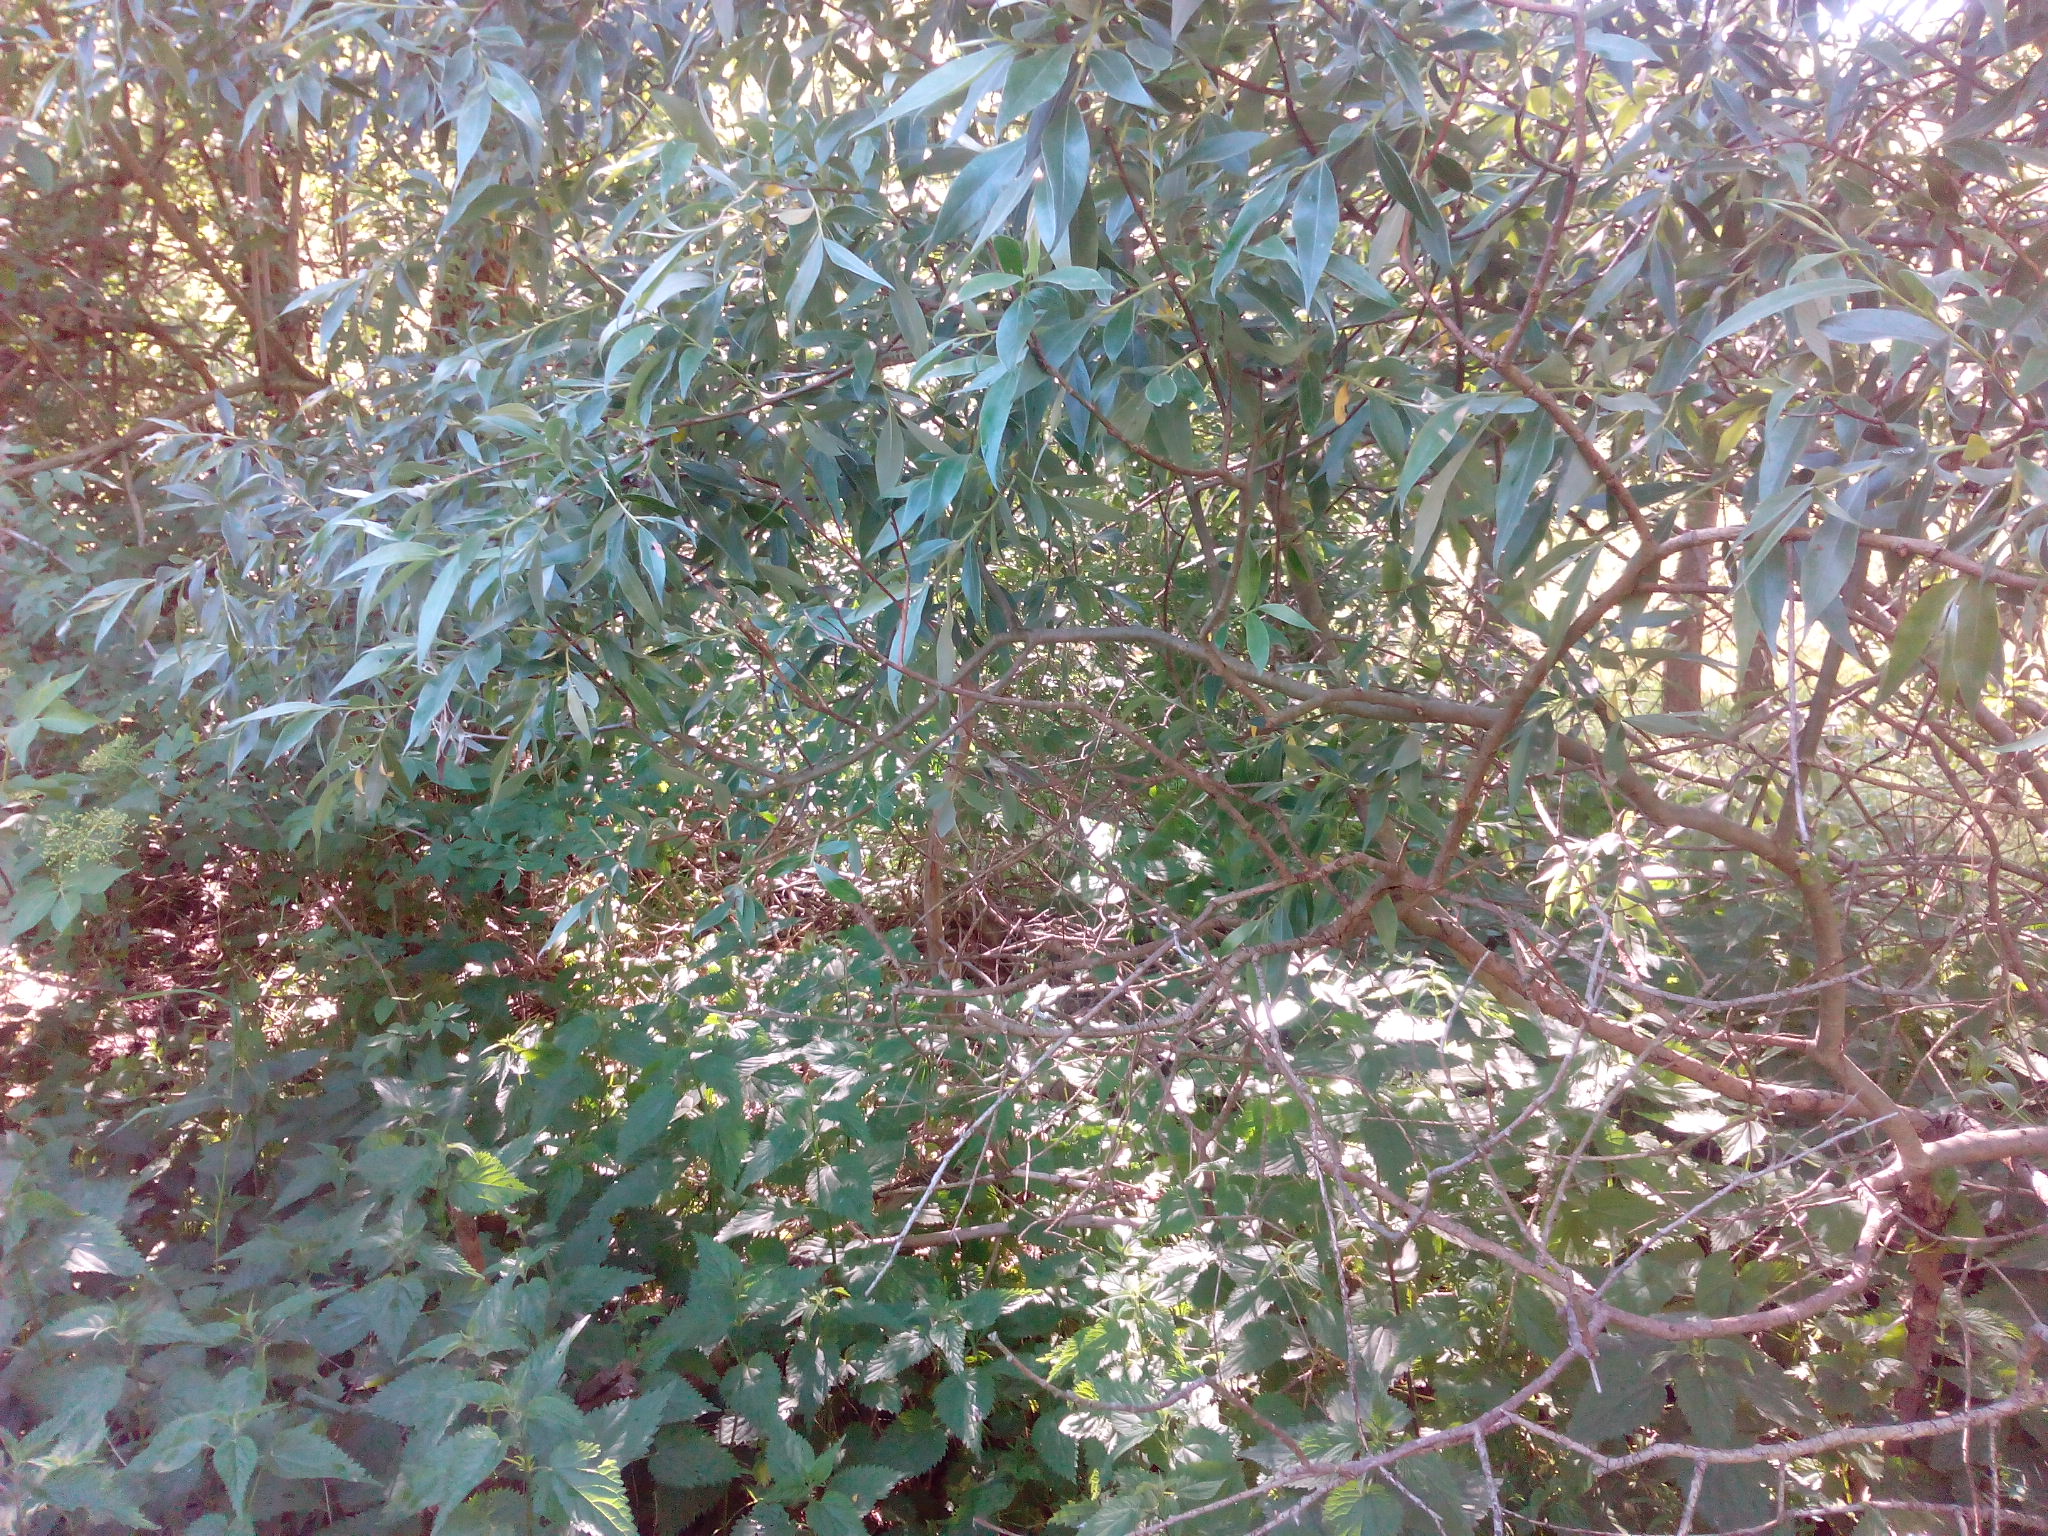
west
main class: Woodland
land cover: Broadleaved woodland
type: mesophytic deciduous forest
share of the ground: 25 - 50 %
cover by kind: broadleaved forest trees 40 %, herbaceous plants 30 %, shrubs 20 %, coniferous forest trees 10 %
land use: Forestry
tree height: > 5 m
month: June
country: DE
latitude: 53.1322
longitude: 14.1708
